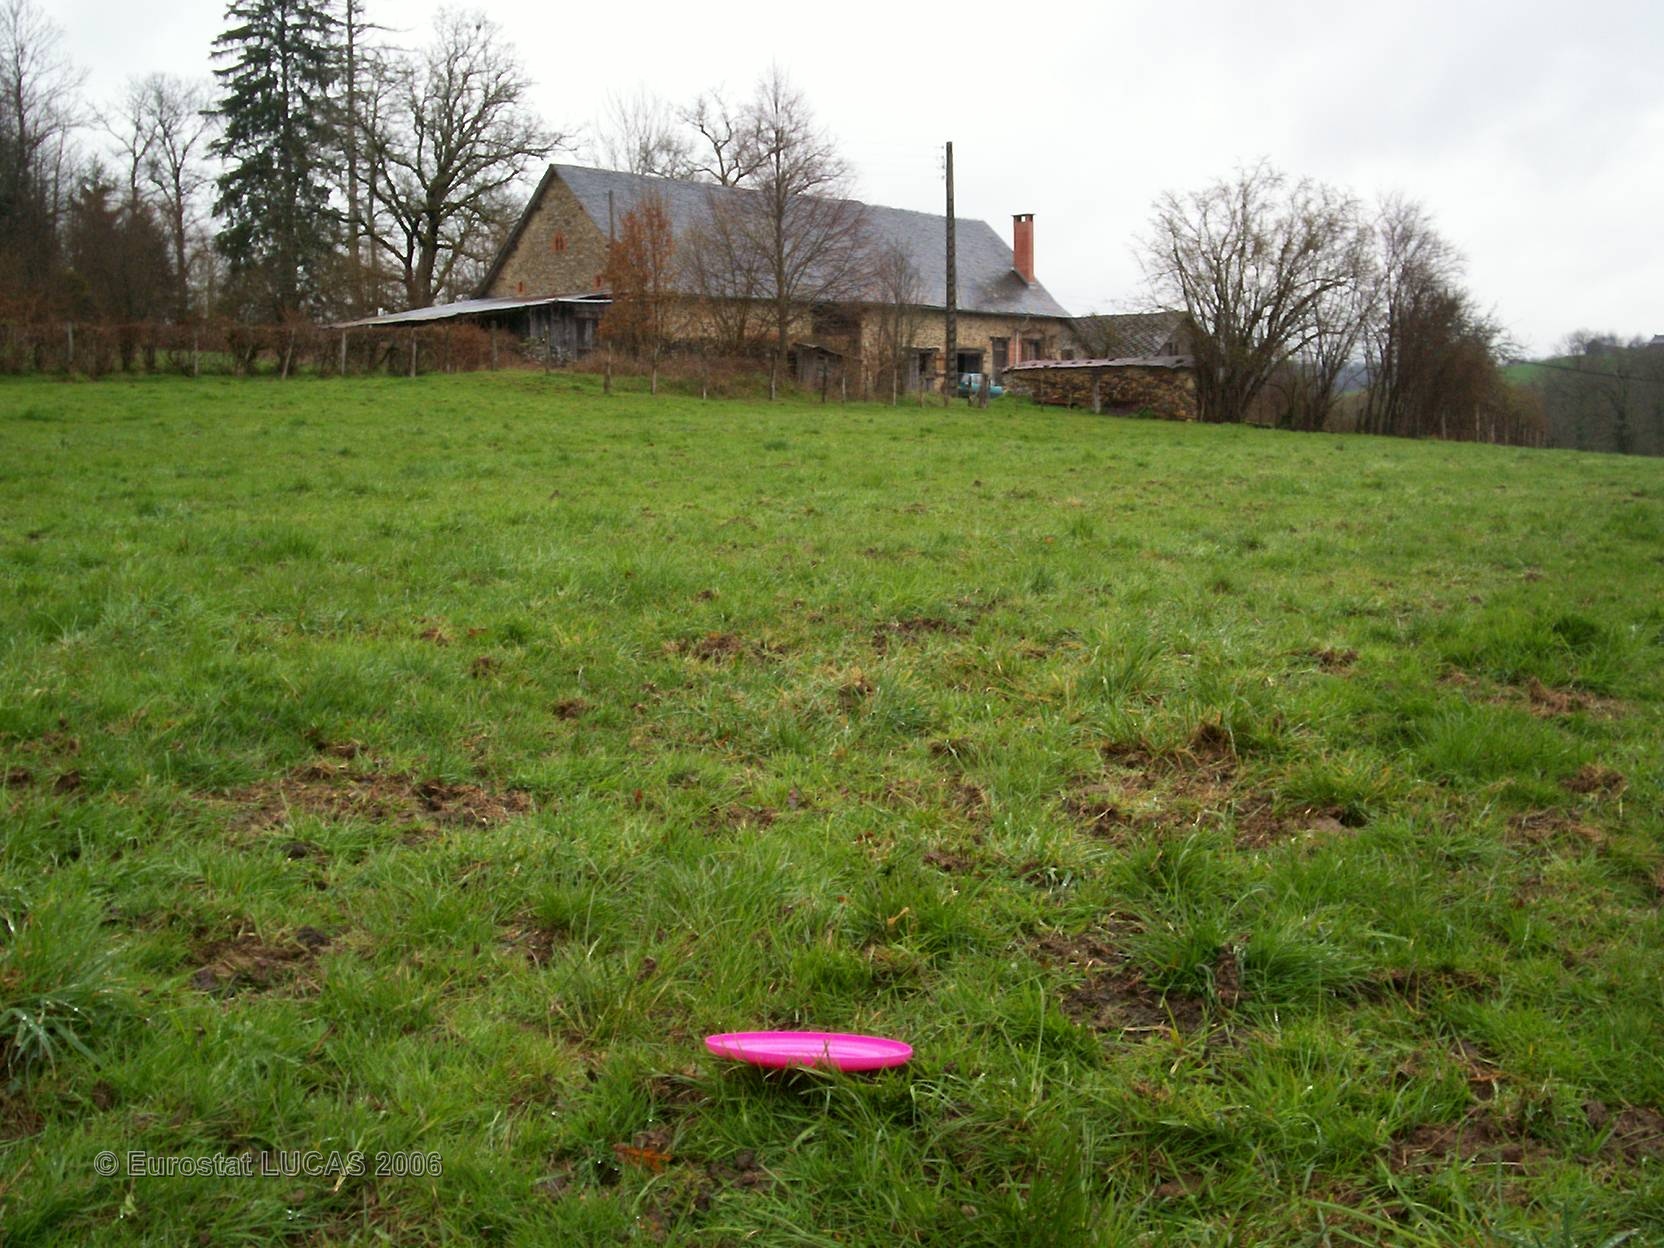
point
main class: Grassland
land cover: Grassland without tree/shrub cover
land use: Agriculture (excluding fallow land and kitchen gardens)
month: April
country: FR
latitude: 45.4763
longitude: 1.5897
